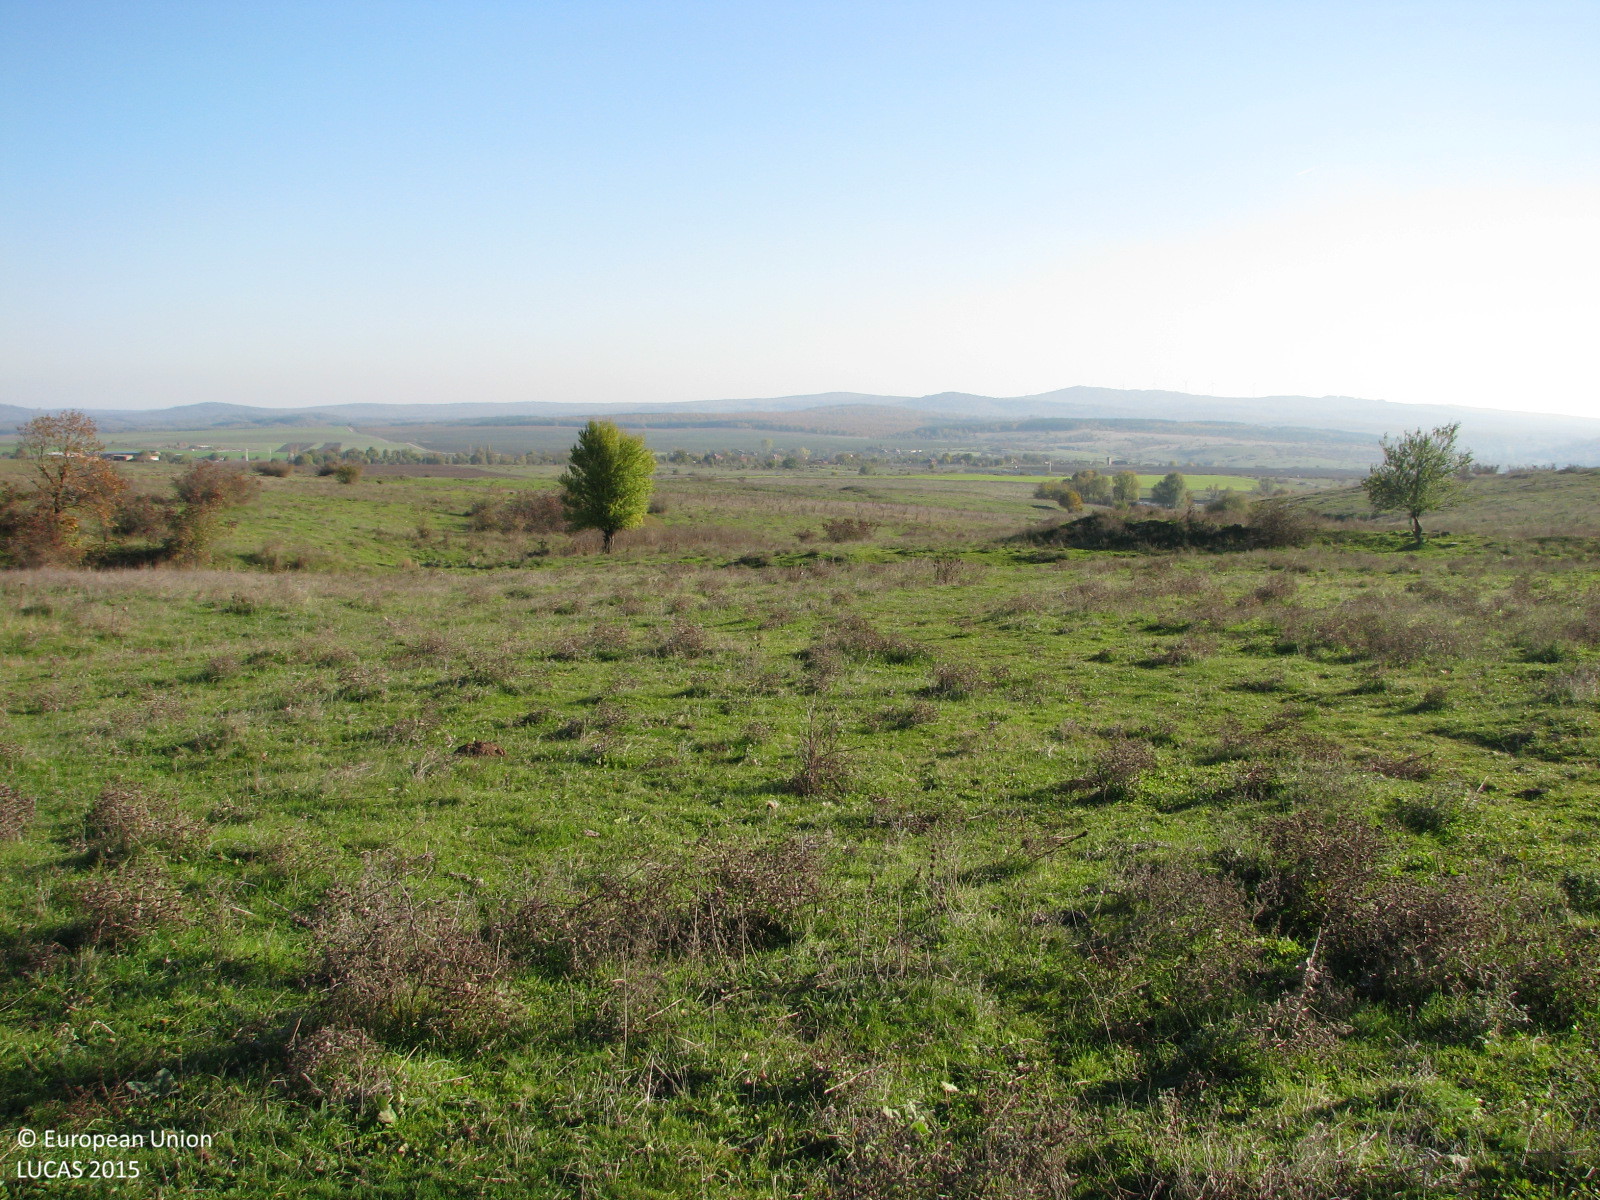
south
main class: Grassland
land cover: Grassland without tree/shrub cover
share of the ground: > 75 %
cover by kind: herbaceous plants 100 %
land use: Agriculture (excluding fallow land and kitchen gardens)
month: November
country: BG
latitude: 42.0659
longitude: 26.8079
